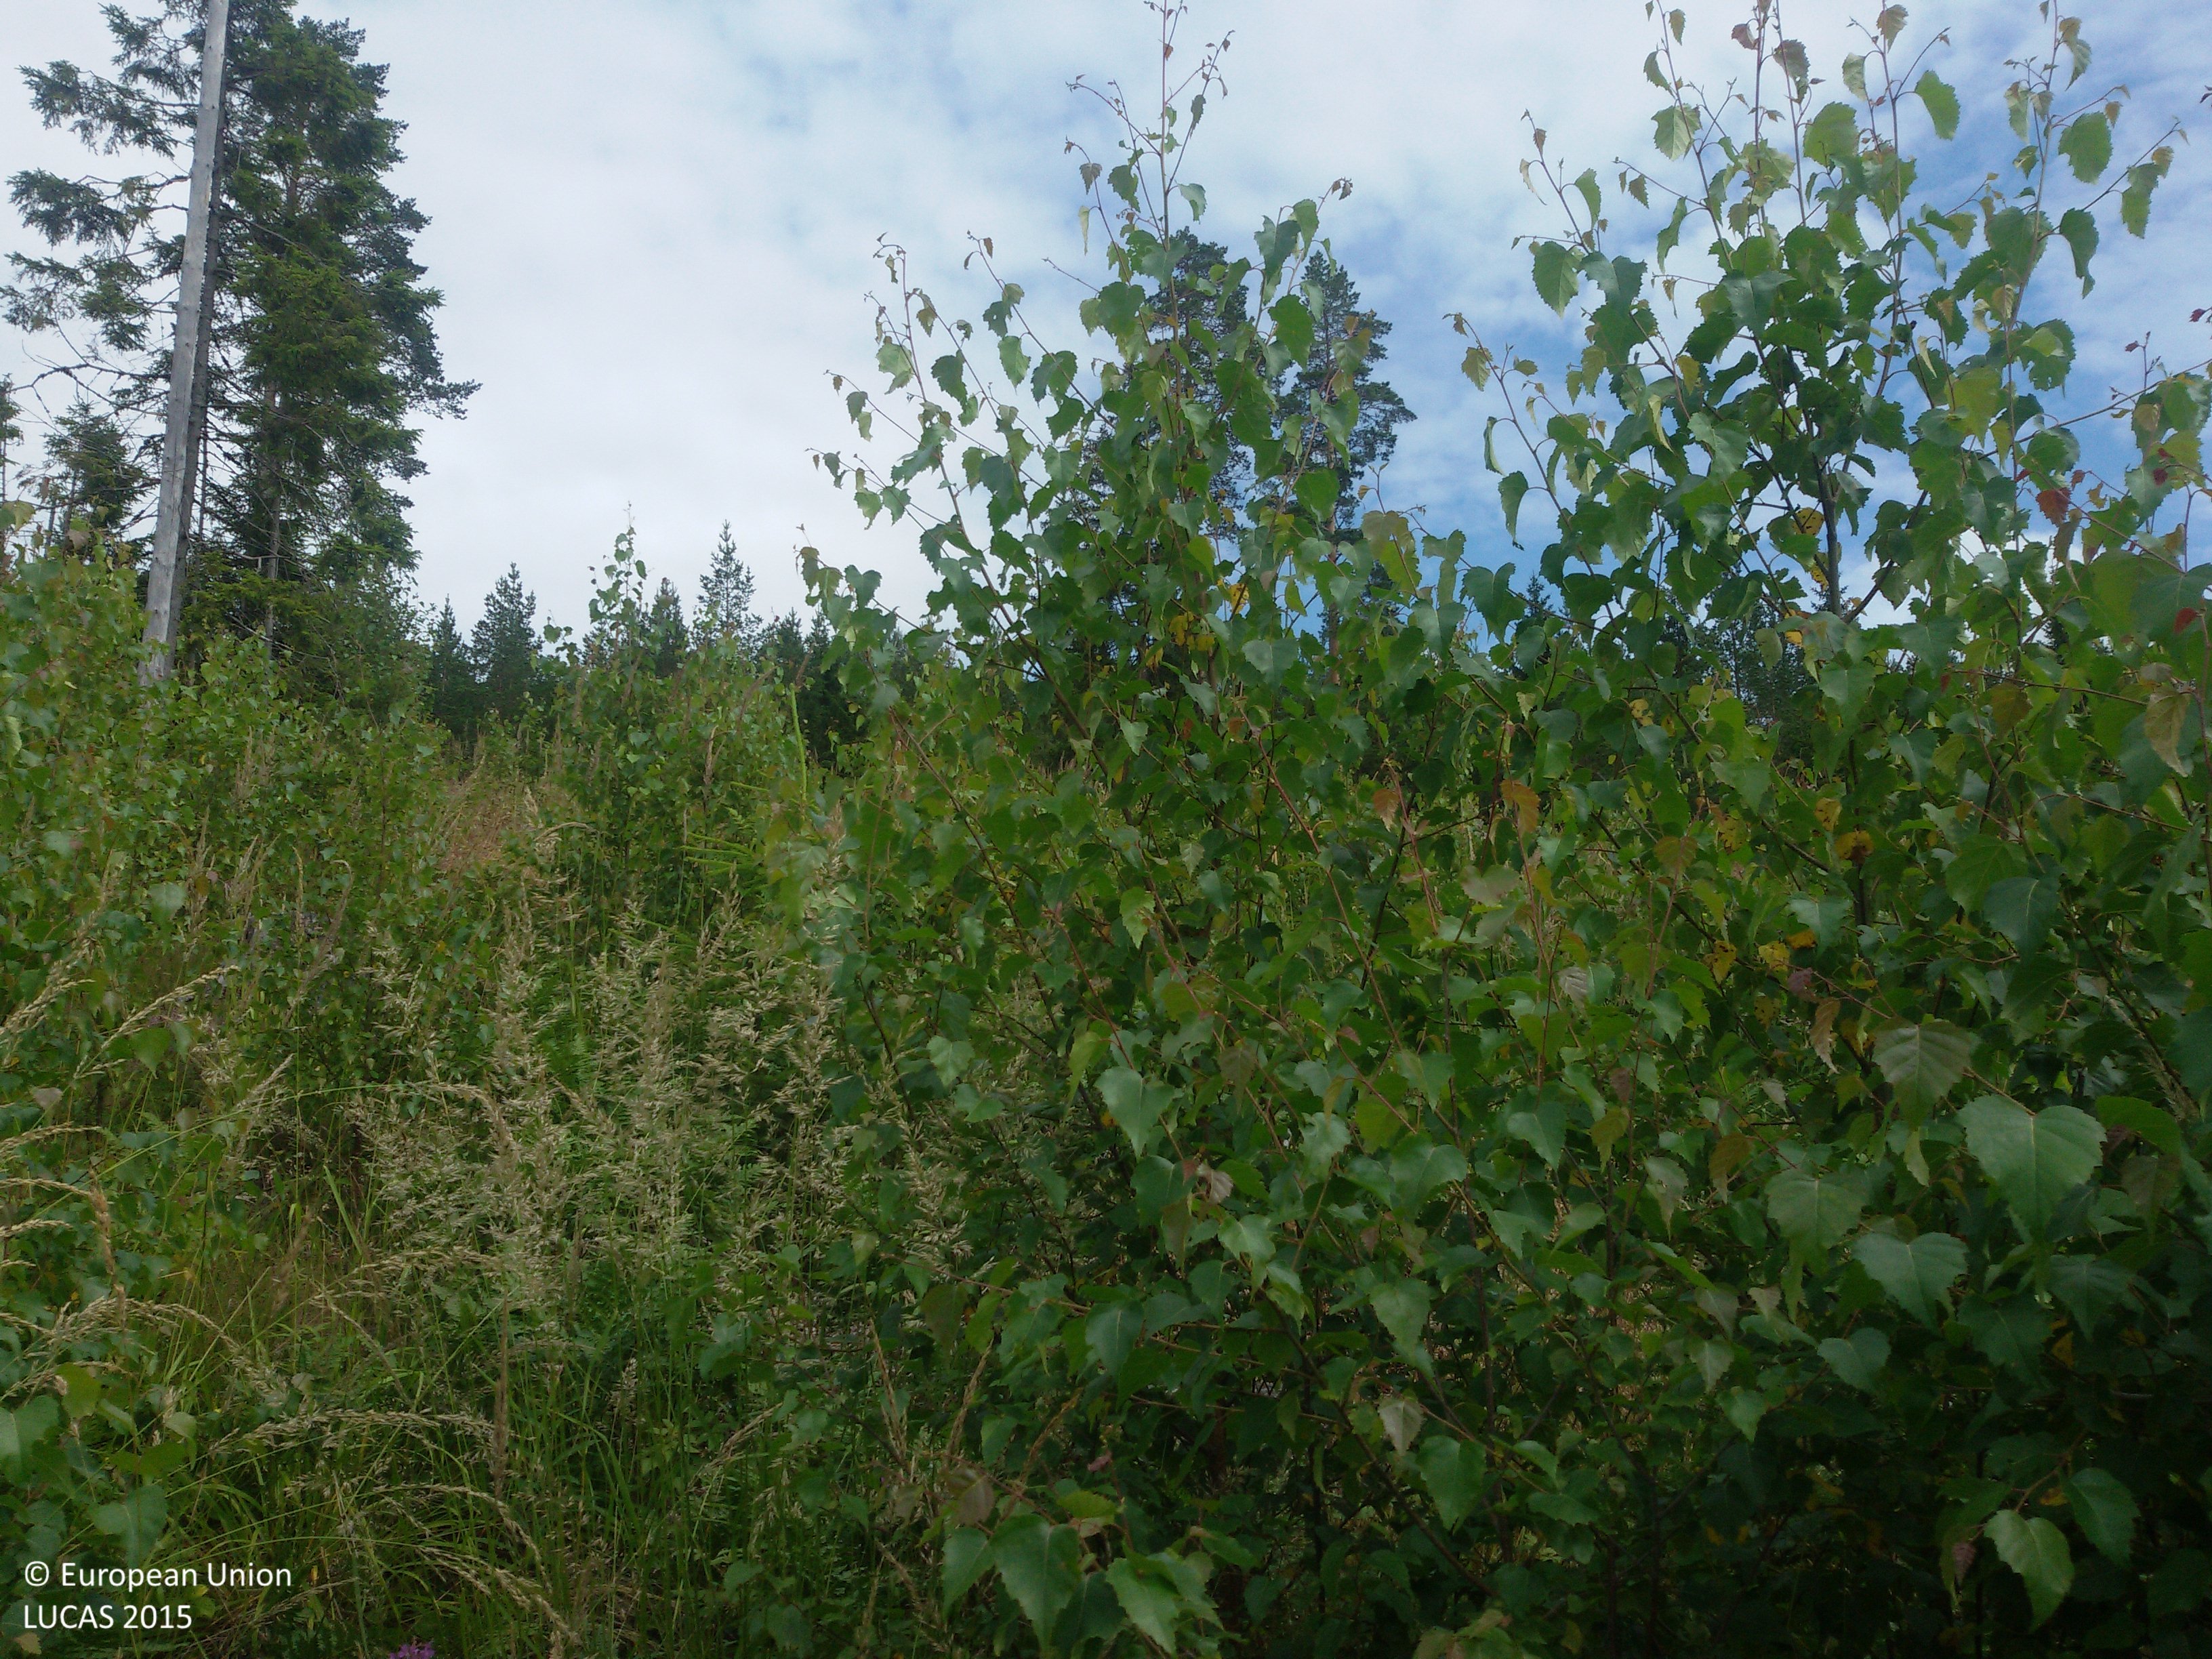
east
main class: Woodland
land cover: Broadleaved woodland
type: boreal forest
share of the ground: 50 - 75 %
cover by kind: broadleaved forest trees 55 %, herbaceous plants 40 %, coniferous forest trees 5 %
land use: Forestry
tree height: < 5 m
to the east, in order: Broadleaved woodland; Tracks; Pine dominated coniferous woodland; Tracks; Pine dominated coniferous woodland; Tracks; Pine dominated coniferous woodland
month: July
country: SE
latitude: 60.4830
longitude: 16.0837
